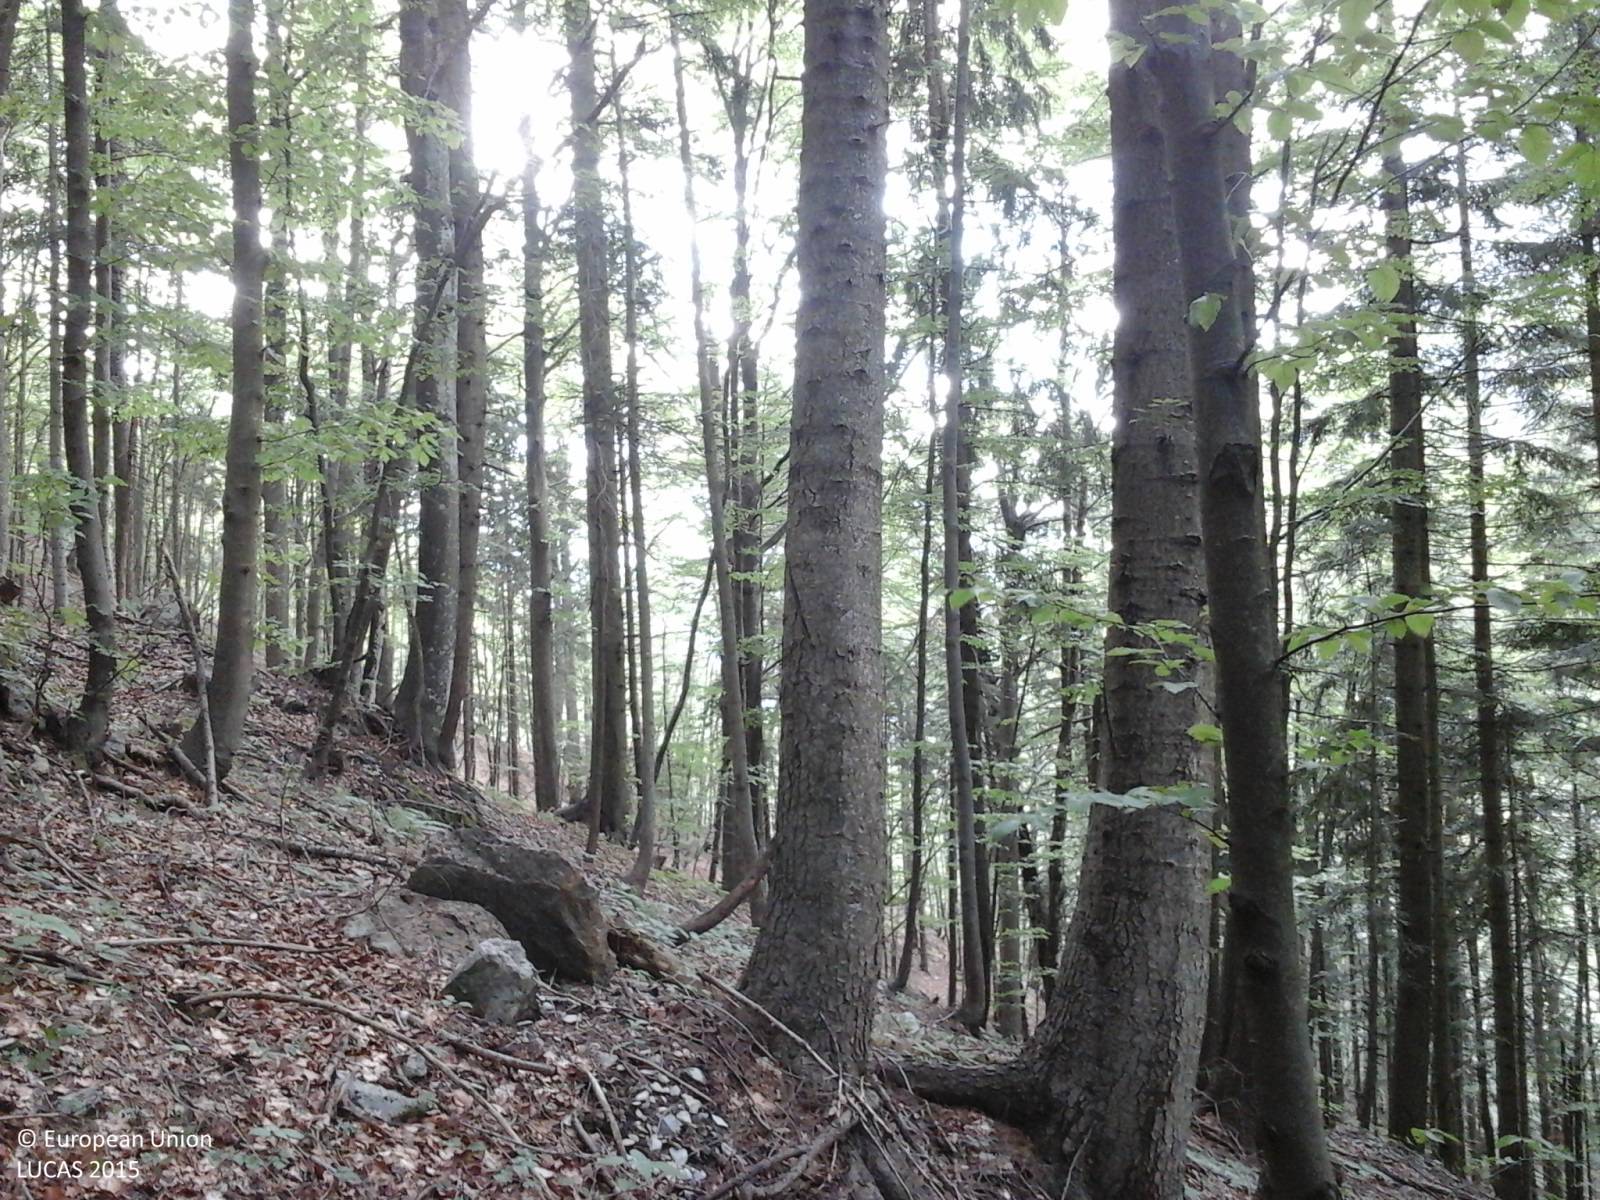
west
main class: Woodland
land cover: Other mixed woodland
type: mountainous beech forest
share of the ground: > 75 %
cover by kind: coniferous forest trees 50 %, broadleaved forest trees 50 %
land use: Forestry
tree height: > 5 m
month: June
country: IT
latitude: 46.5004
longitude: 13.2416
